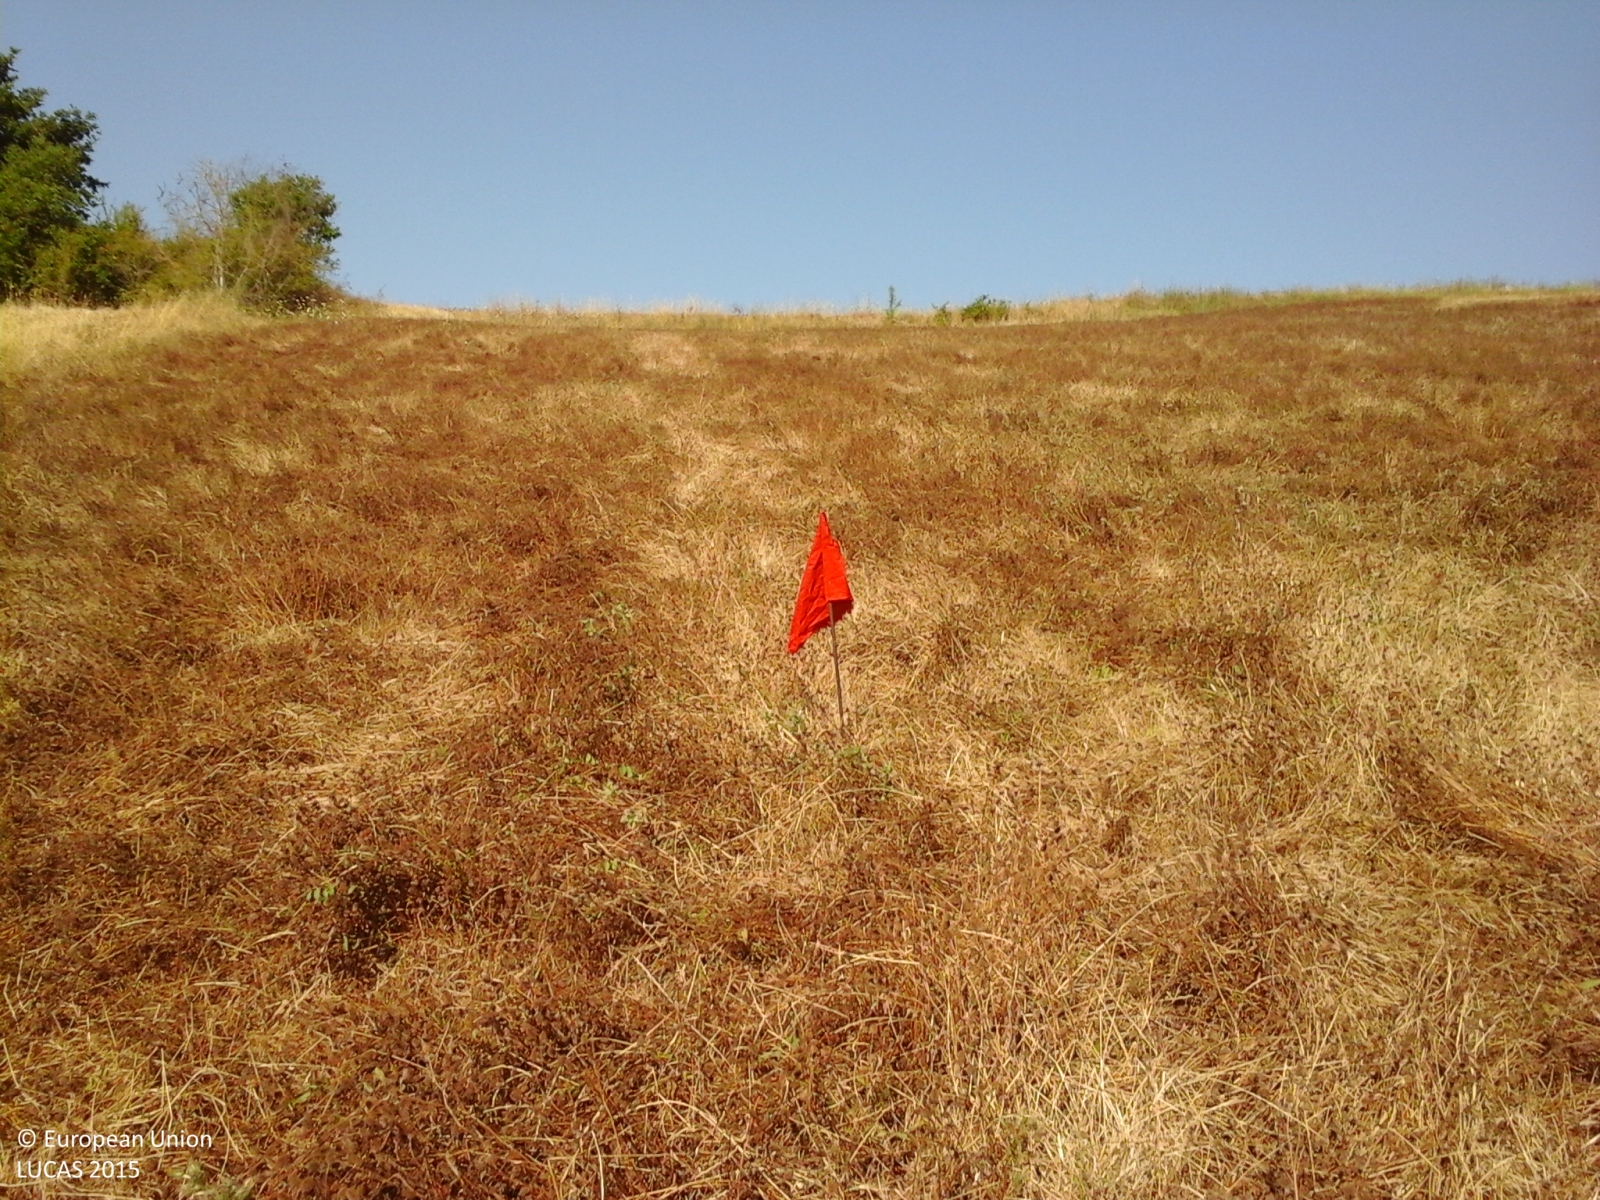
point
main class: Cropland
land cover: Temporary grasslands
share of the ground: > 75 %
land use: Agriculture (excluding fallow land and kitchen gardens)
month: July
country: IT
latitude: 43.0202
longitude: 11.6270
